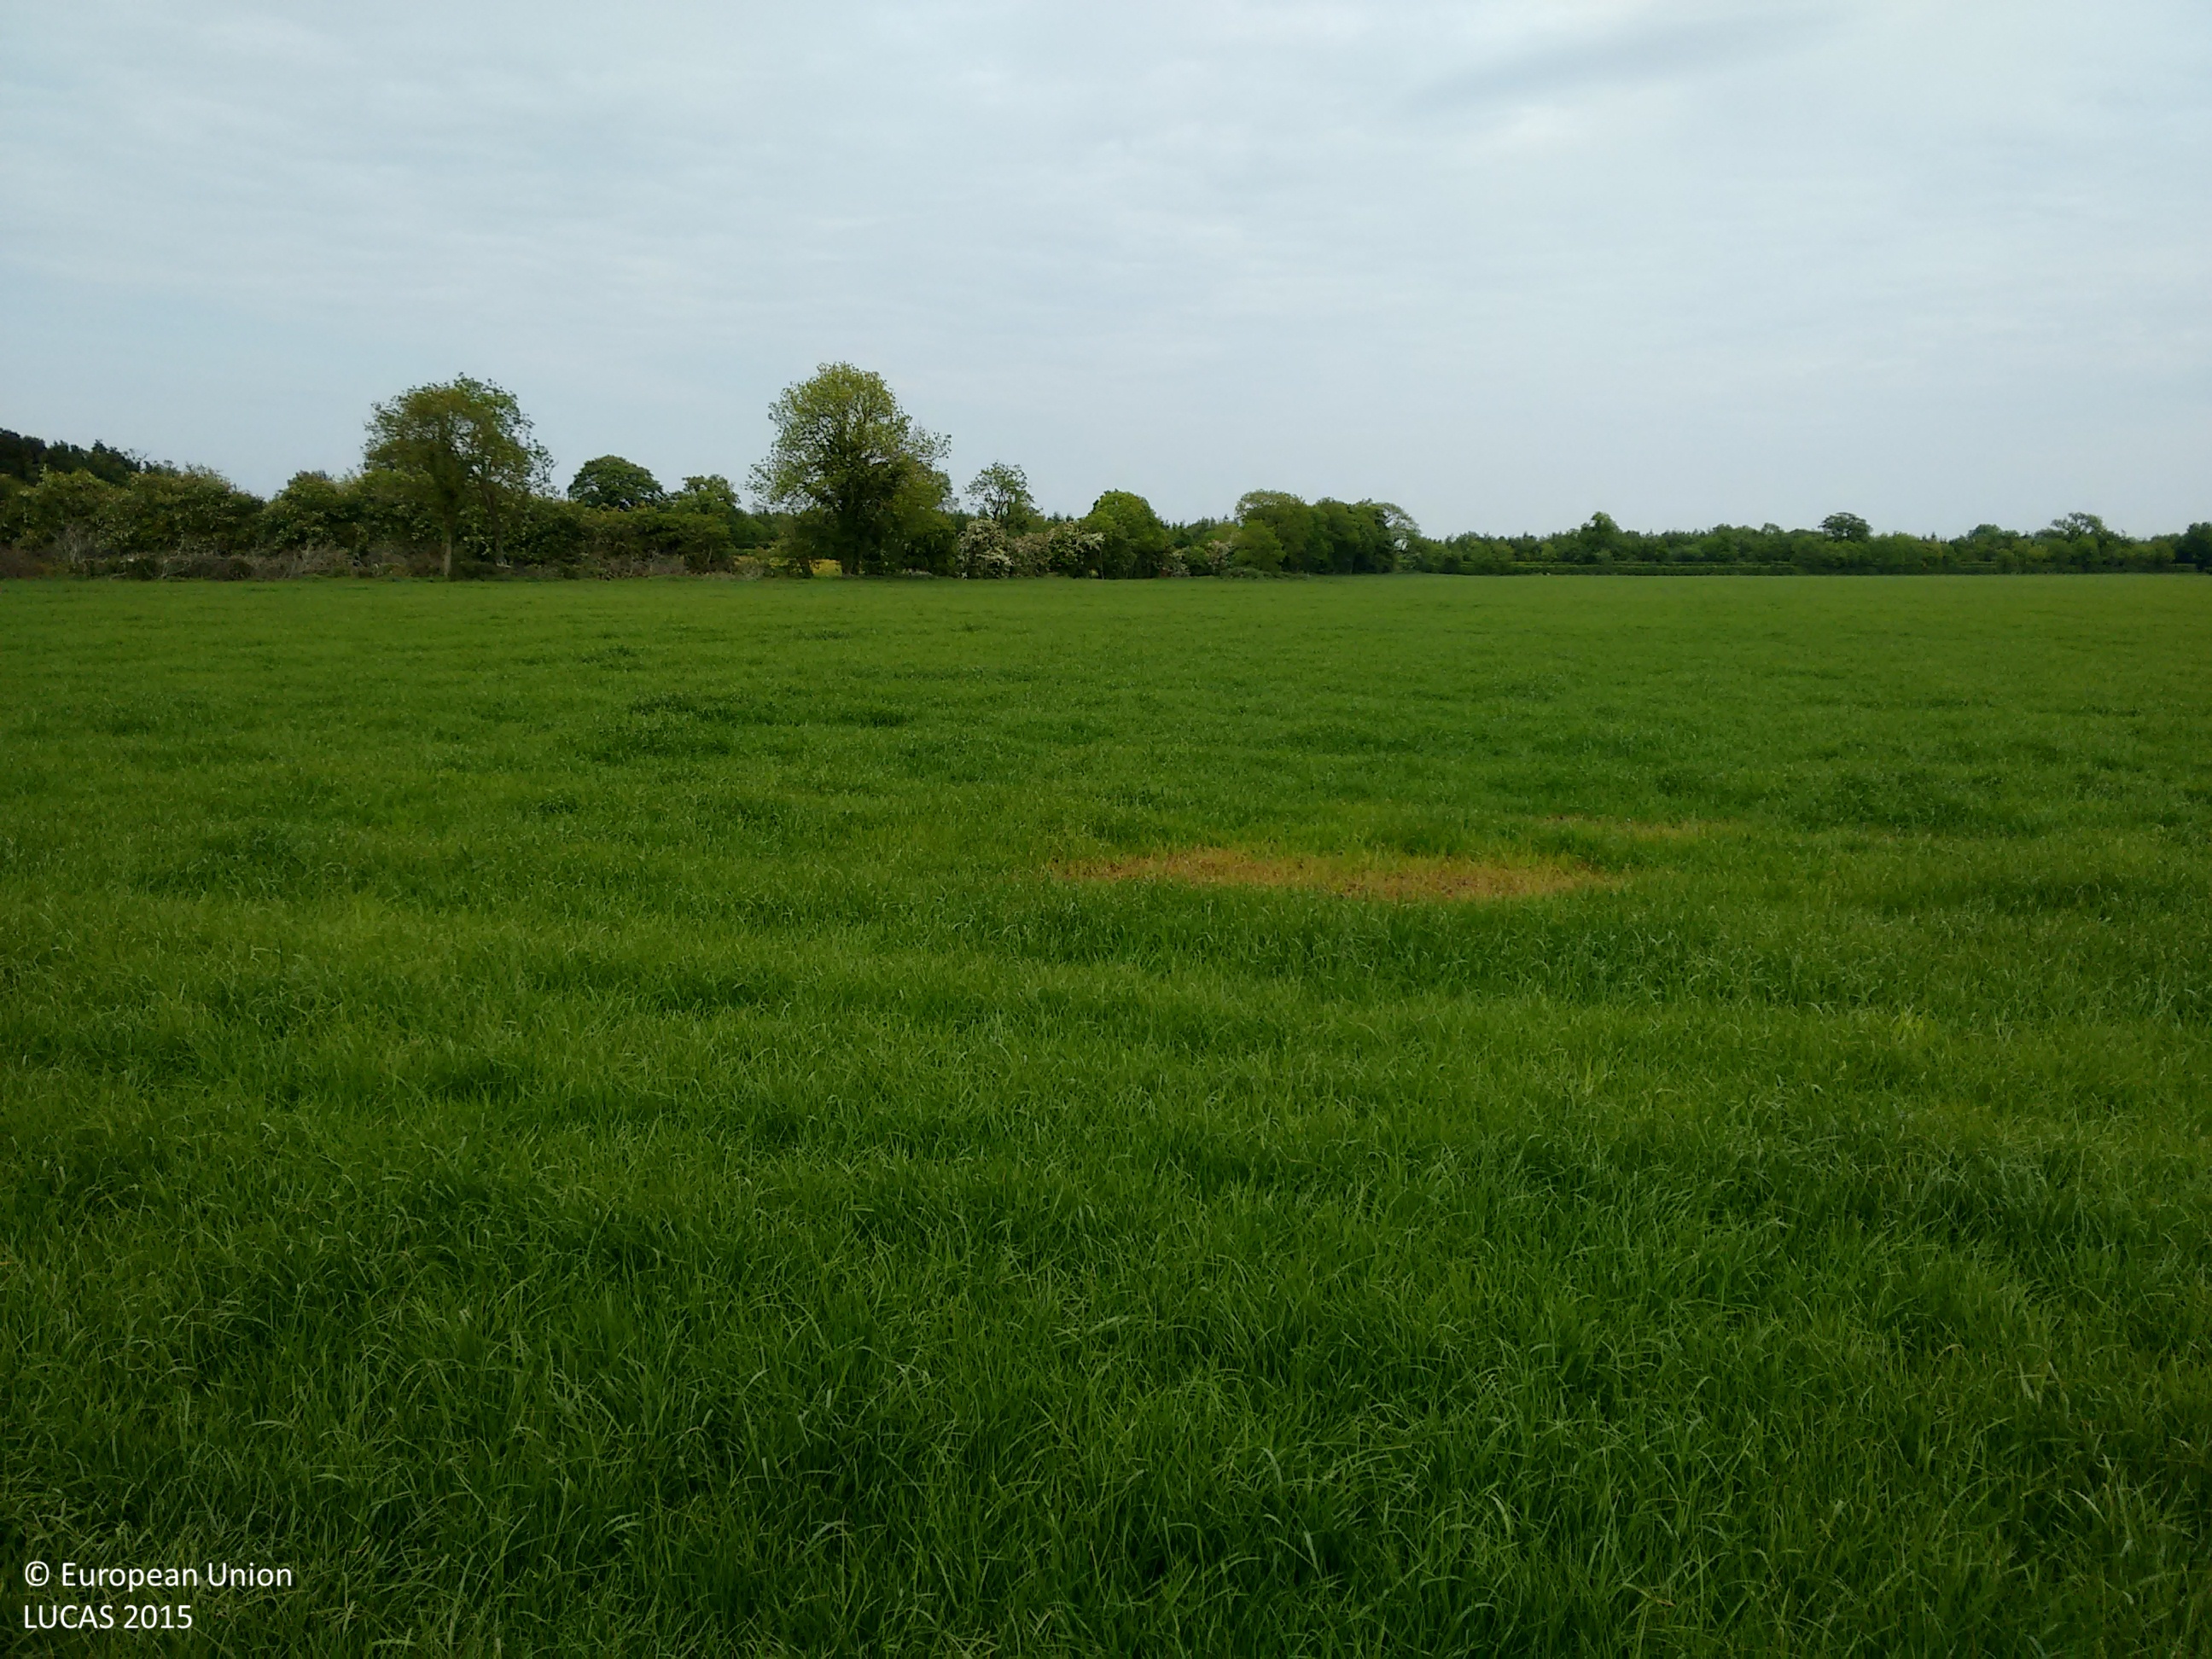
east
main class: Grassland
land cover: Grassland without tree/shrub cover
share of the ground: > 75 %
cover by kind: herbaceous plants 95 %, unconsolidated bare surface 5 %
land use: Agriculture (excluding fallow land and kitchen gardens)
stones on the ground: < 10 %
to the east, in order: Grassland without tree/shrub cover
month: June
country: IE
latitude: 53.5583
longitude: -6.5372
